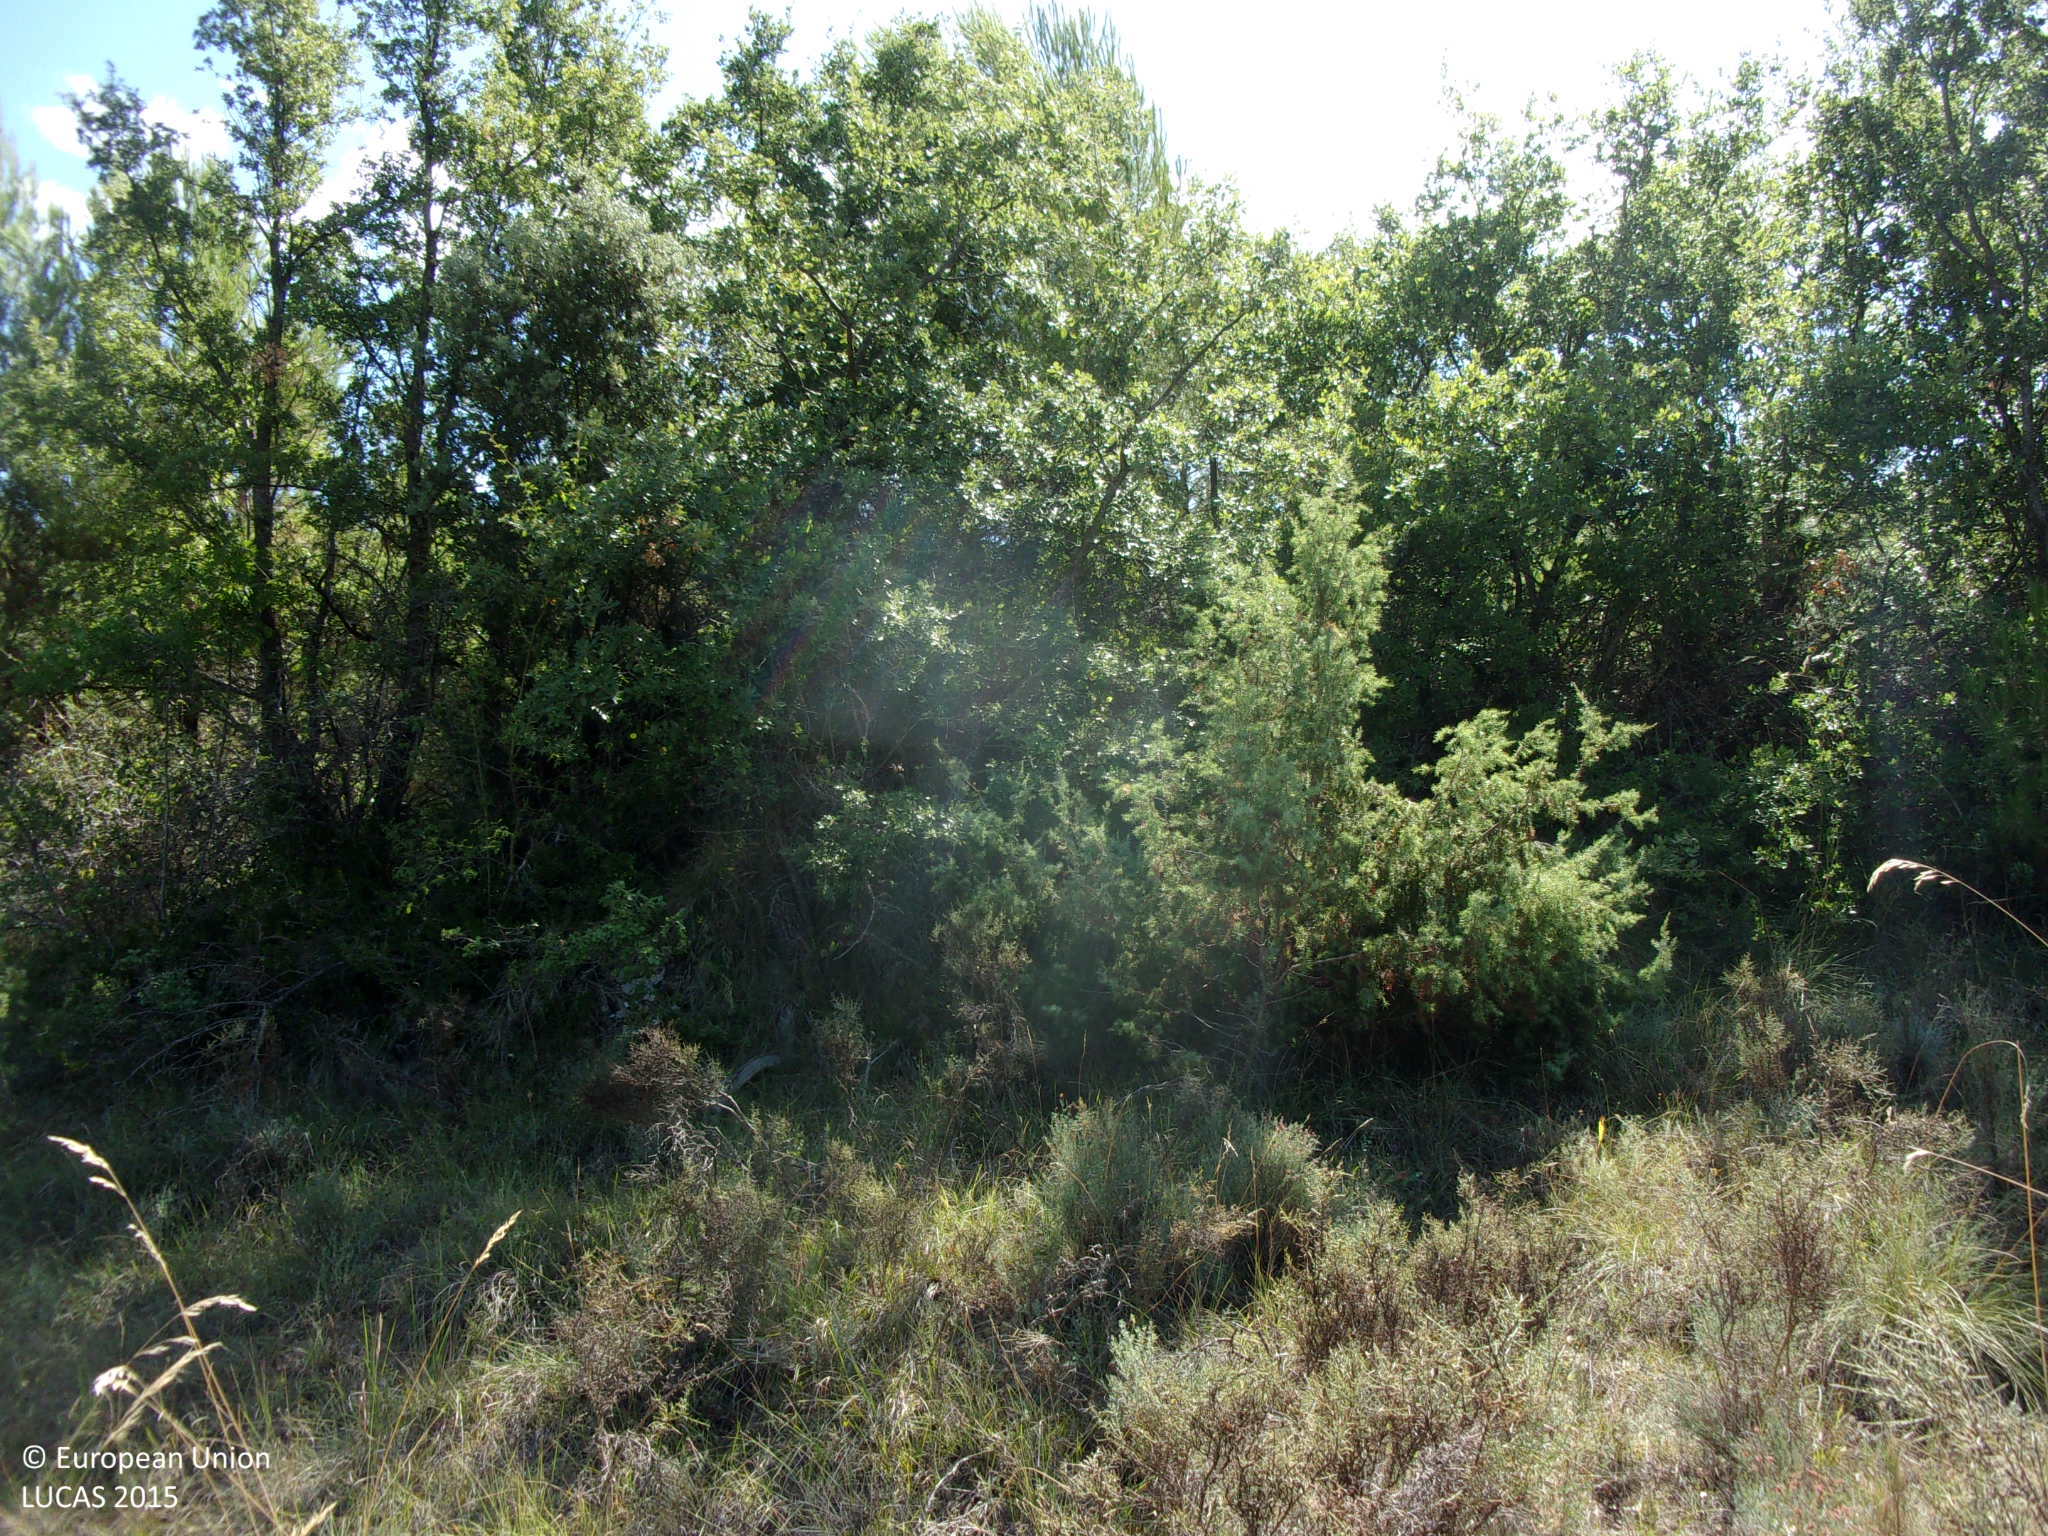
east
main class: Woodland
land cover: Broadleaved woodland
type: thermophilous deciduous forest
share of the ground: 25 - 50 %
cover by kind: broadleaved forest trees 40 %, shrubs 40 %, coniferous forest trees 10 %, herbaceous plants 10 %
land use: Forestry
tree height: < 5 m
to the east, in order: Broadleaved woodland; Grassland without tree/shrub cover; Broadleaved woodland; Common wheat
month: August
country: ES
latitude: 42.4135
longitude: -1.1987
